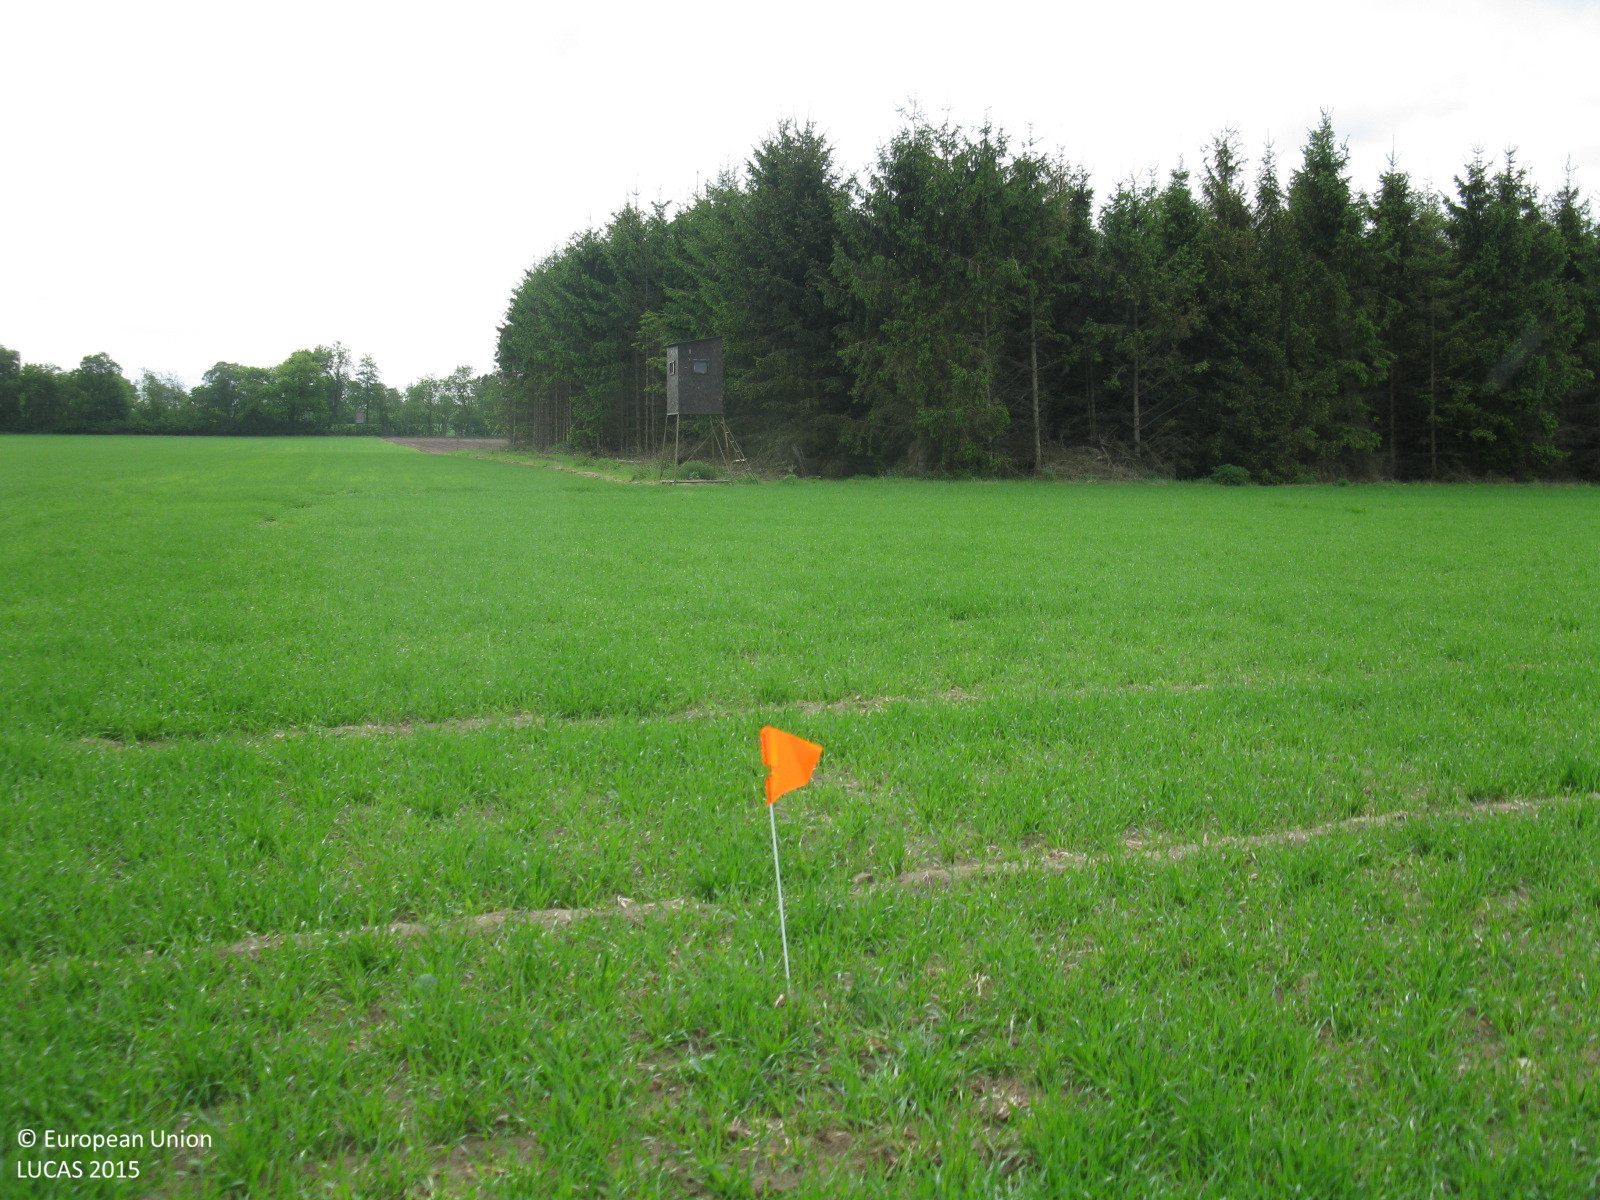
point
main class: Cropland
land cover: Barley
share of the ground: > 75 %
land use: Agriculture (excluding fallow land and kitchen gardens)
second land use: Community services
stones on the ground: < 10 %
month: May
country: DE
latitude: 52.8173
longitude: 7.4335
